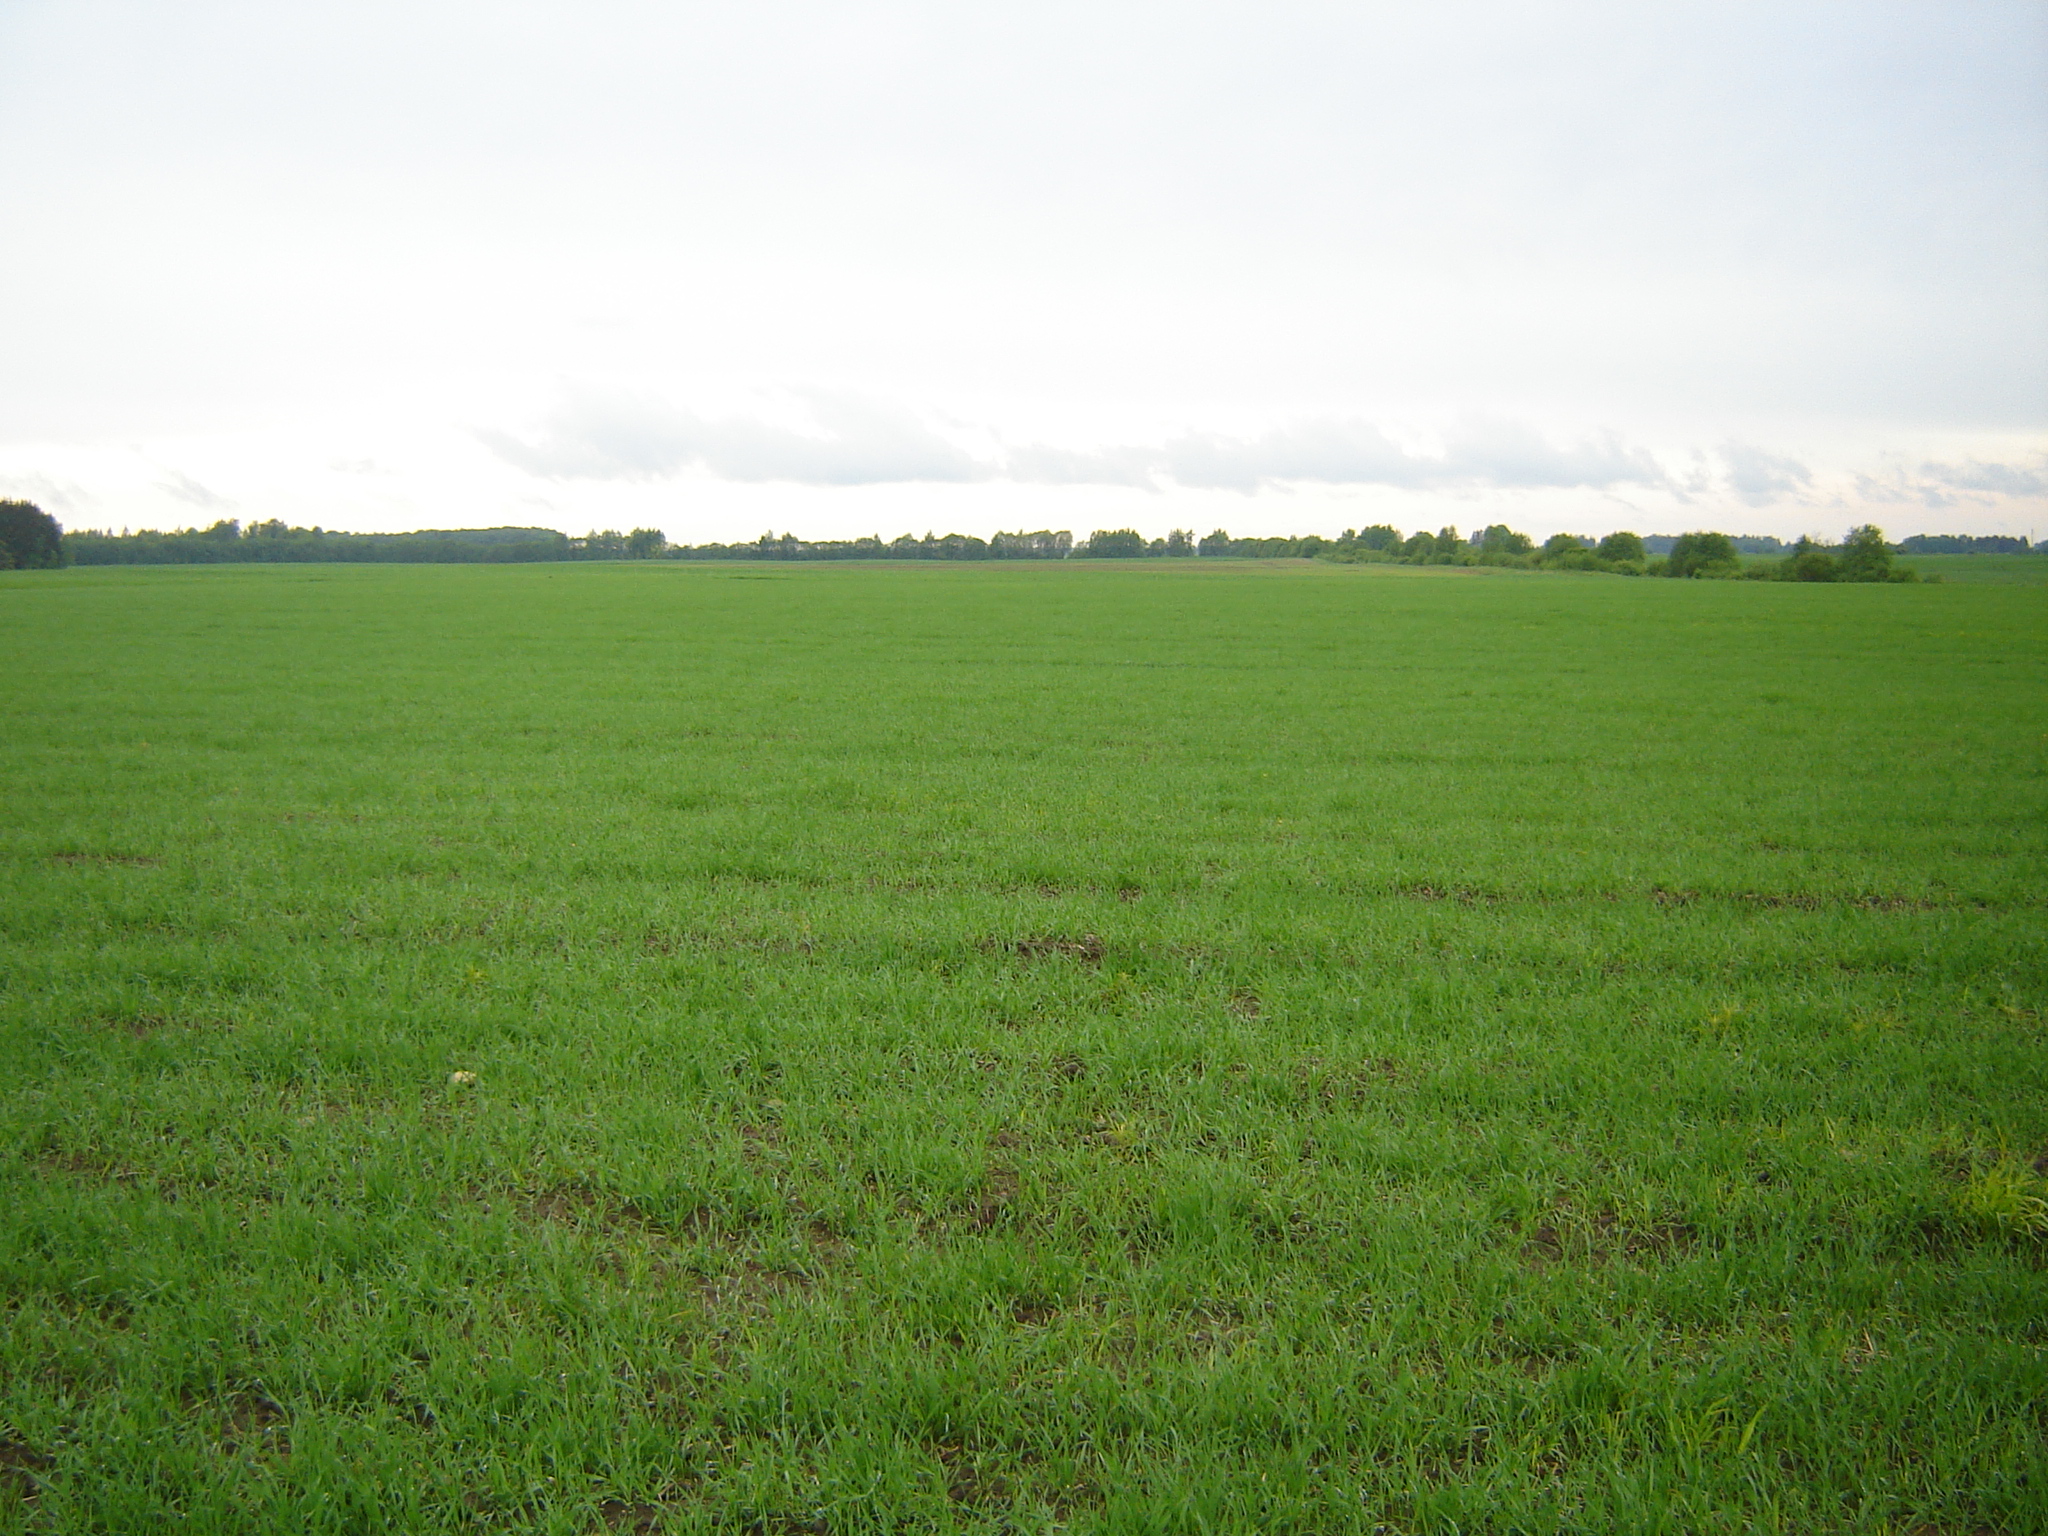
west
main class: Cropland
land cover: Common wheat
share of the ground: 50 - 75 %
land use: Agriculture (excluding fallow land and kitchen gardens)
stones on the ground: < 10 %
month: May
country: LT
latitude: 55.8809
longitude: 25.1894
